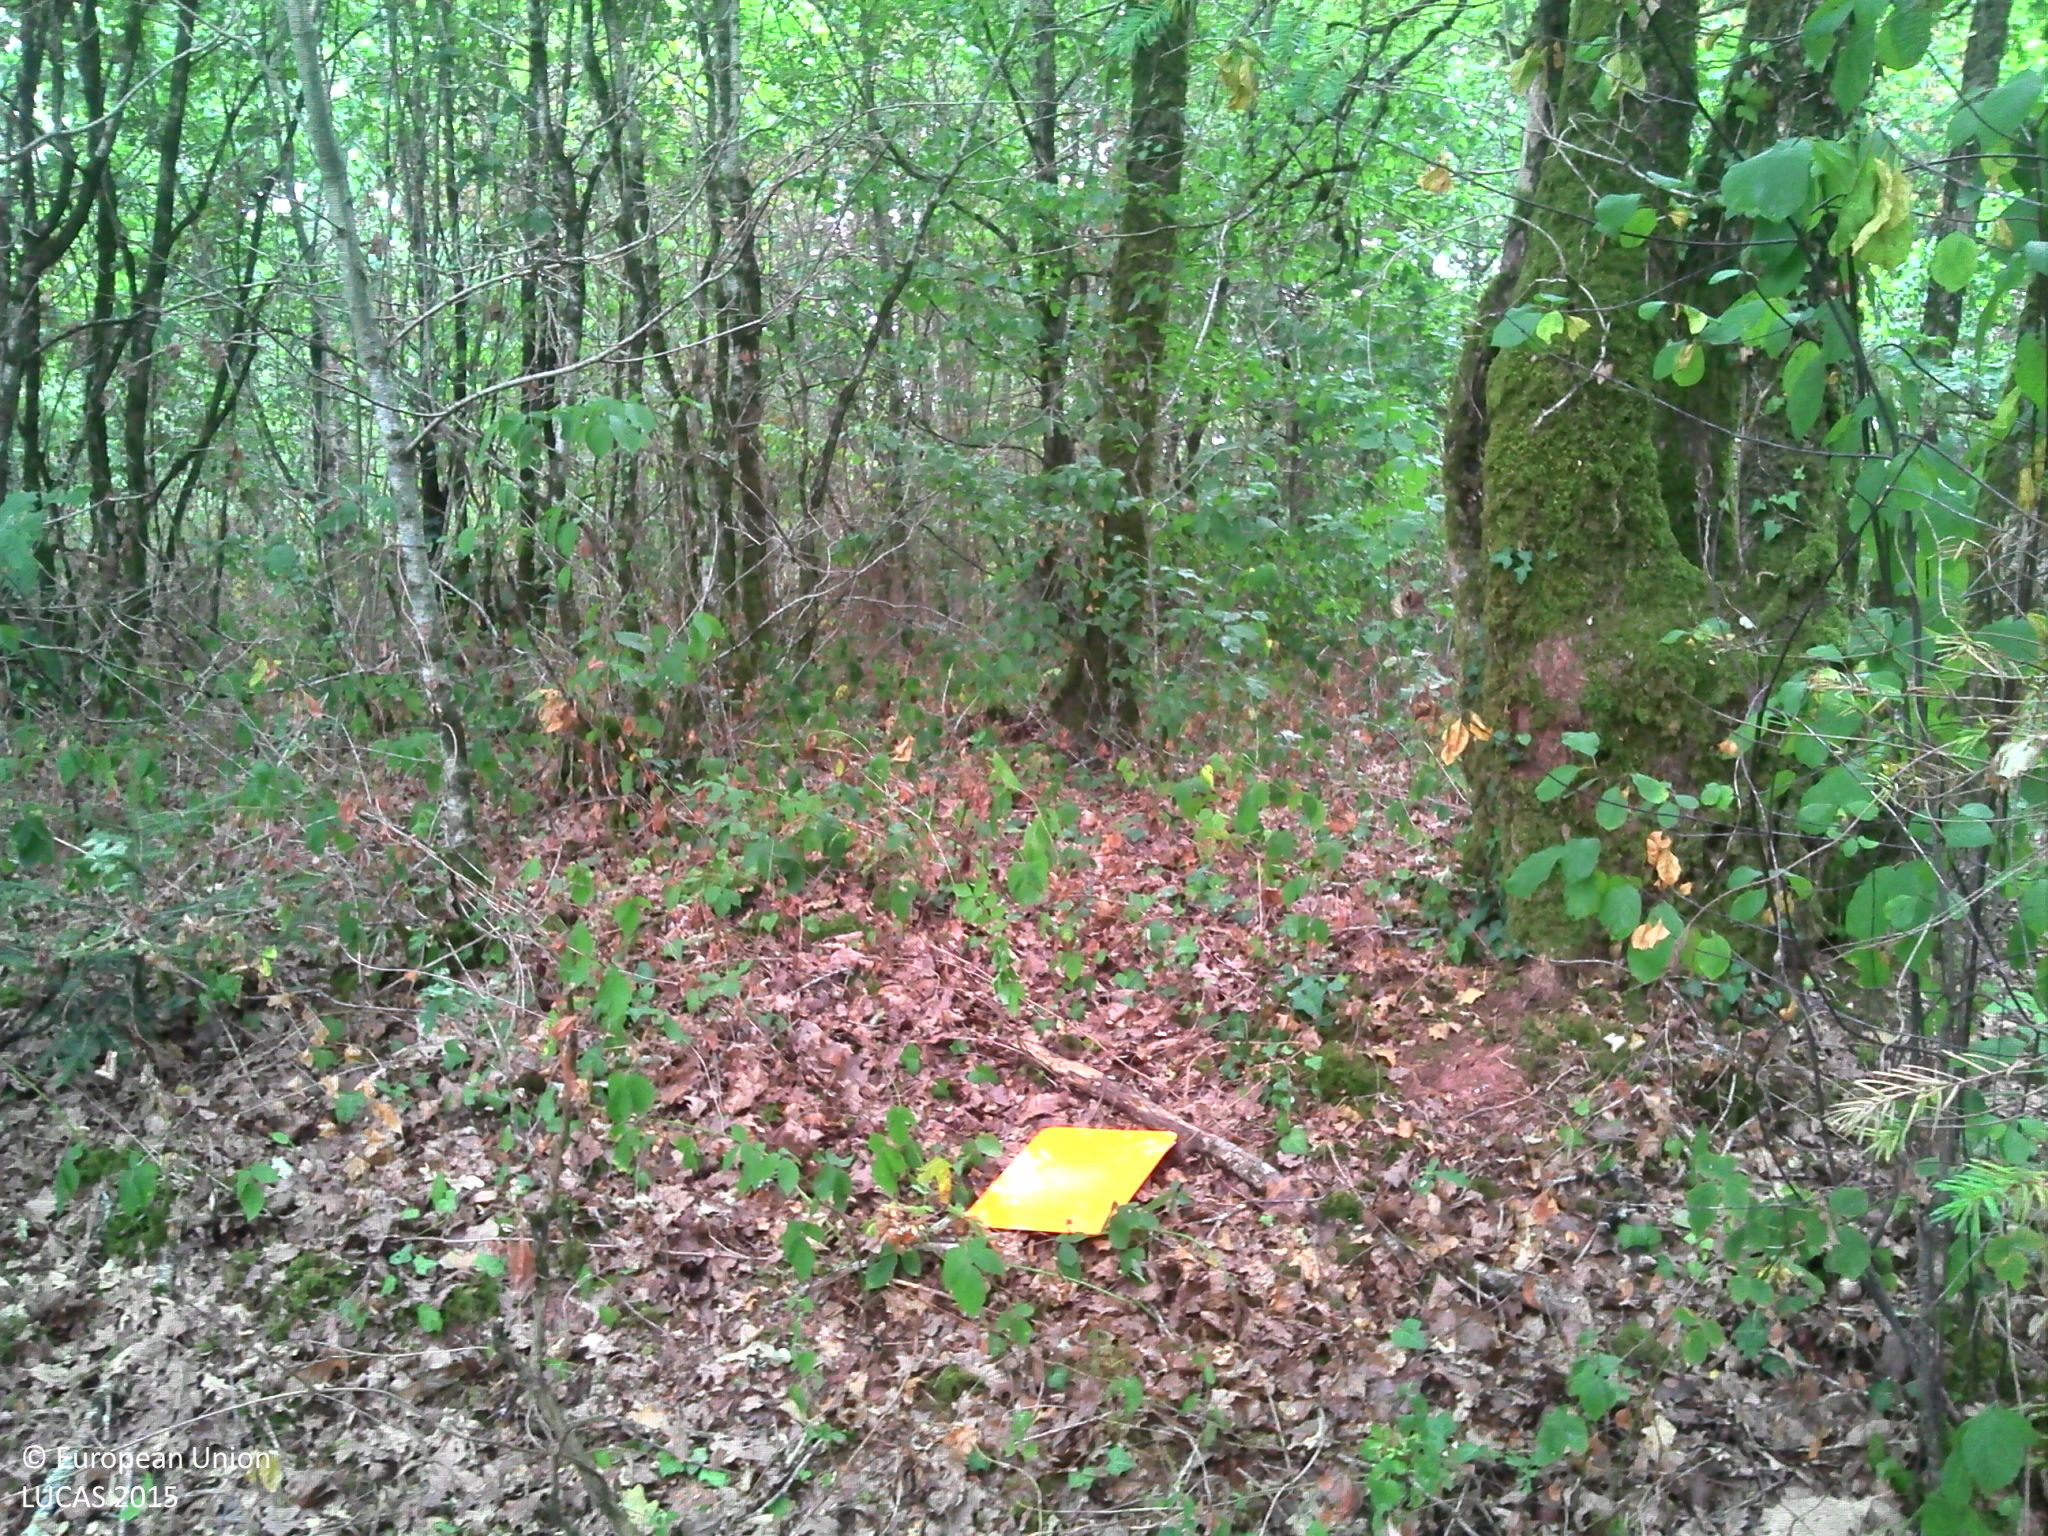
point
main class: Woodland
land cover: Broadleaved woodland
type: acidophilous oak and oak-birch forest
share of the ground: > 75 %
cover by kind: broadleaved forest trees 60 %, herbaceous plants 20 %, lichens and mosses 10 %, coniferous forest trees 5 %, shrubs 5 %
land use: Forestry
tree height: > 5 m
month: July
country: FR
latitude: 45.3126
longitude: 1.3582
